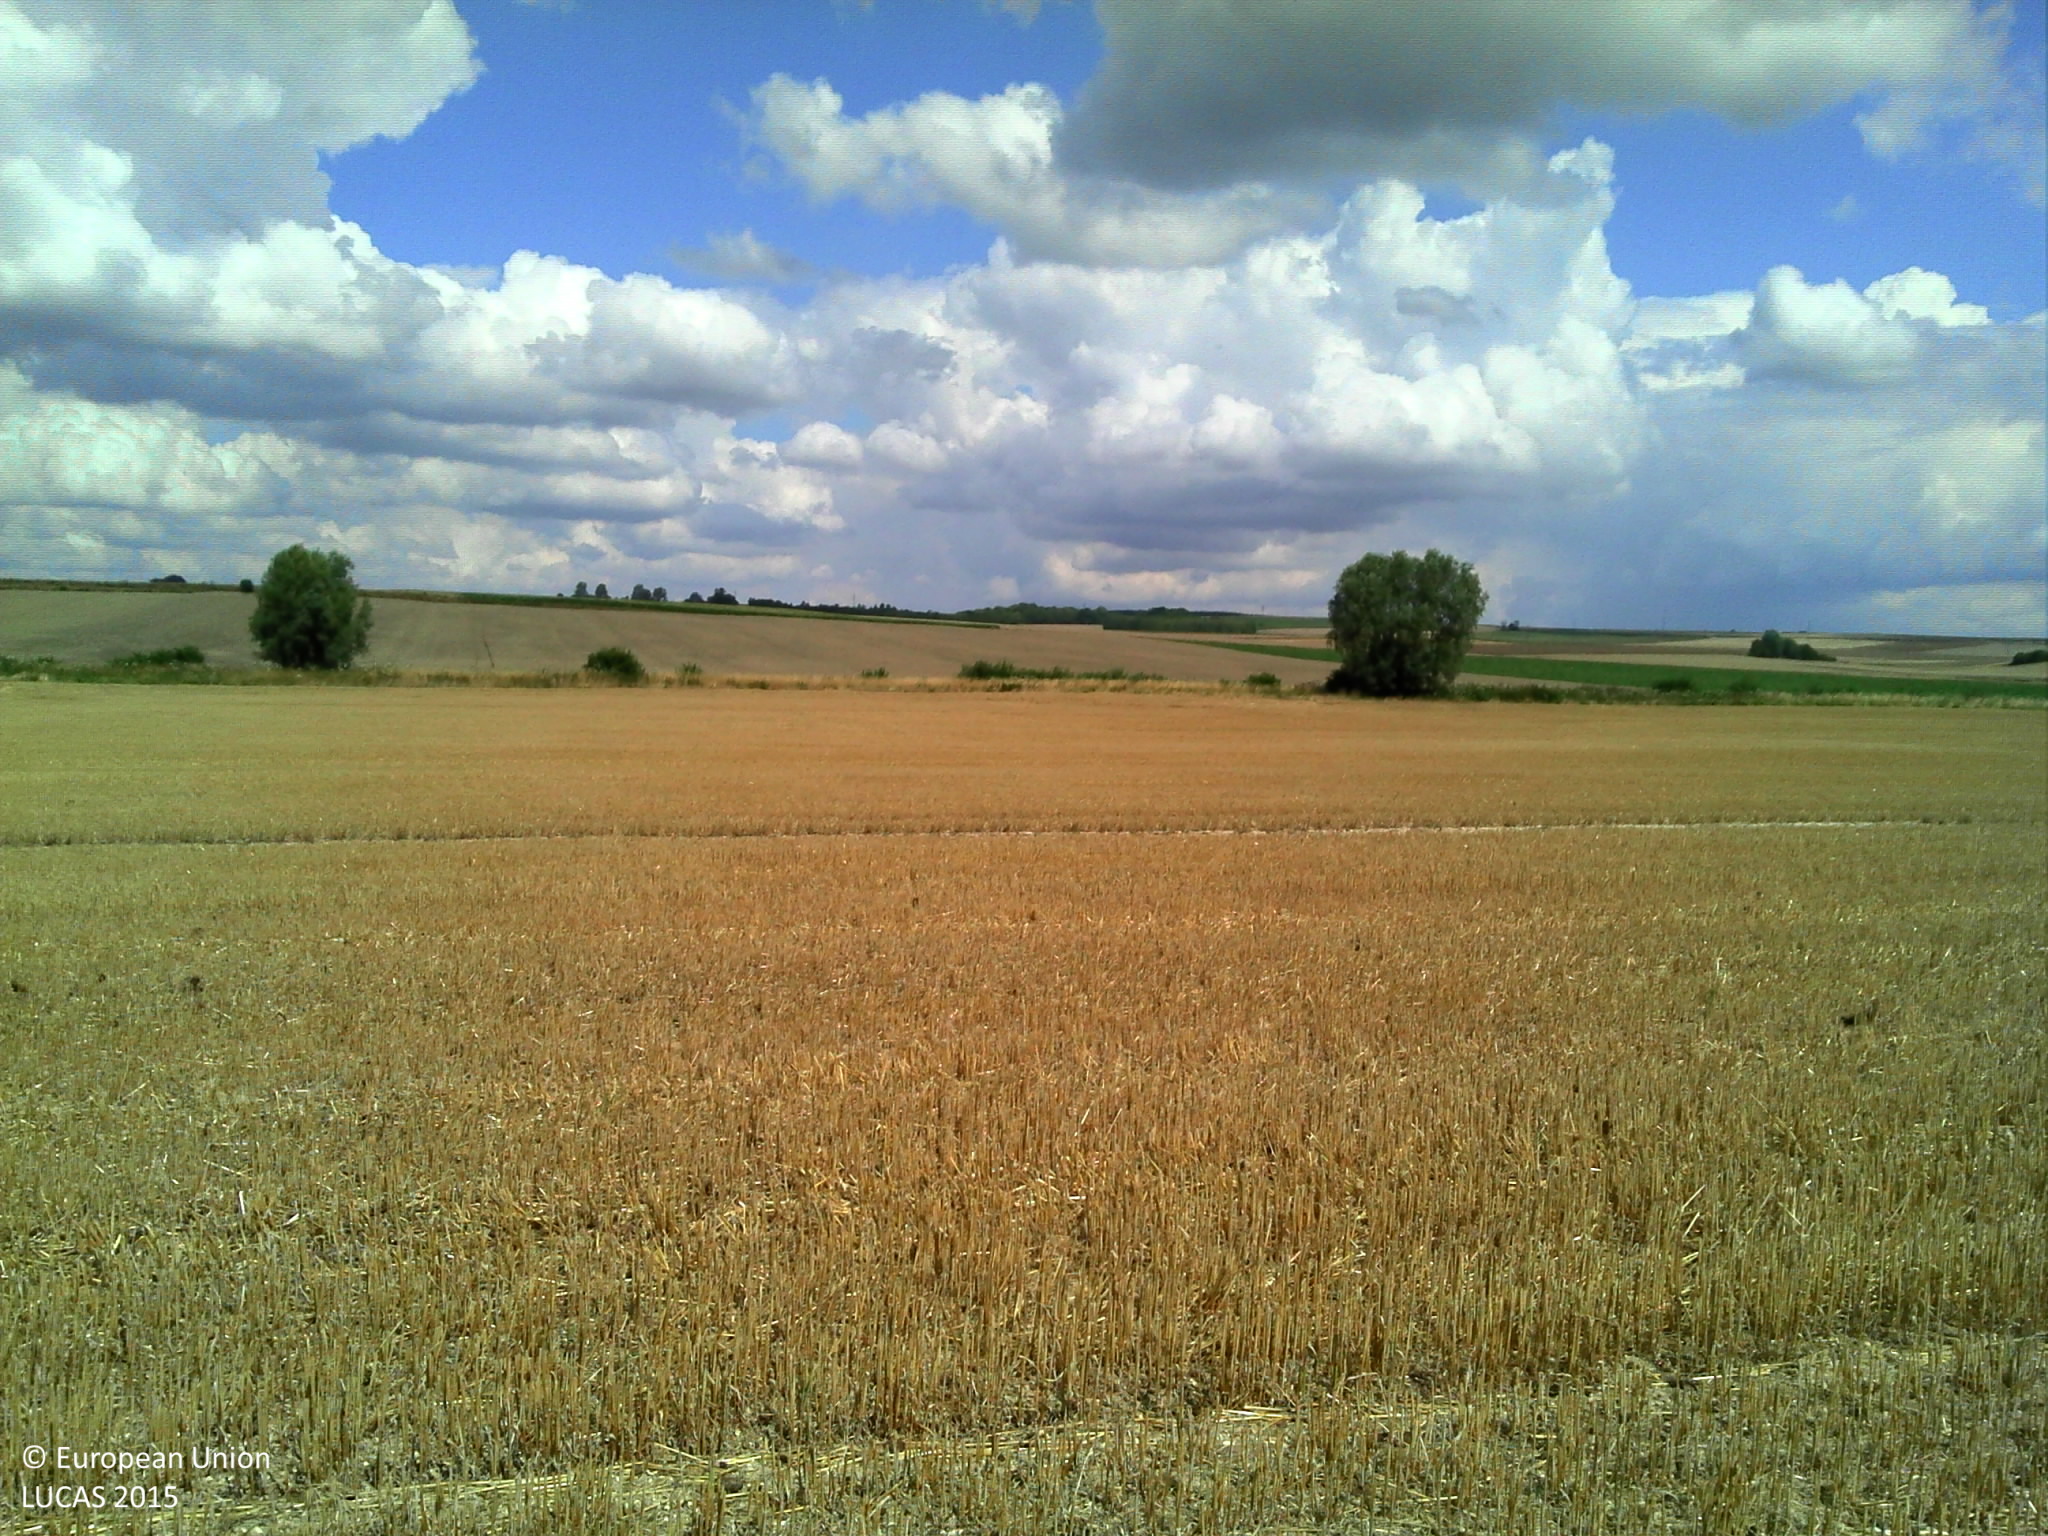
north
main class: Cropland
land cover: Barley
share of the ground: > 75 %
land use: Agriculture (excluding fallow land and kitchen gardens)
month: July
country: FR
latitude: 50.0126
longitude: 2.5500
